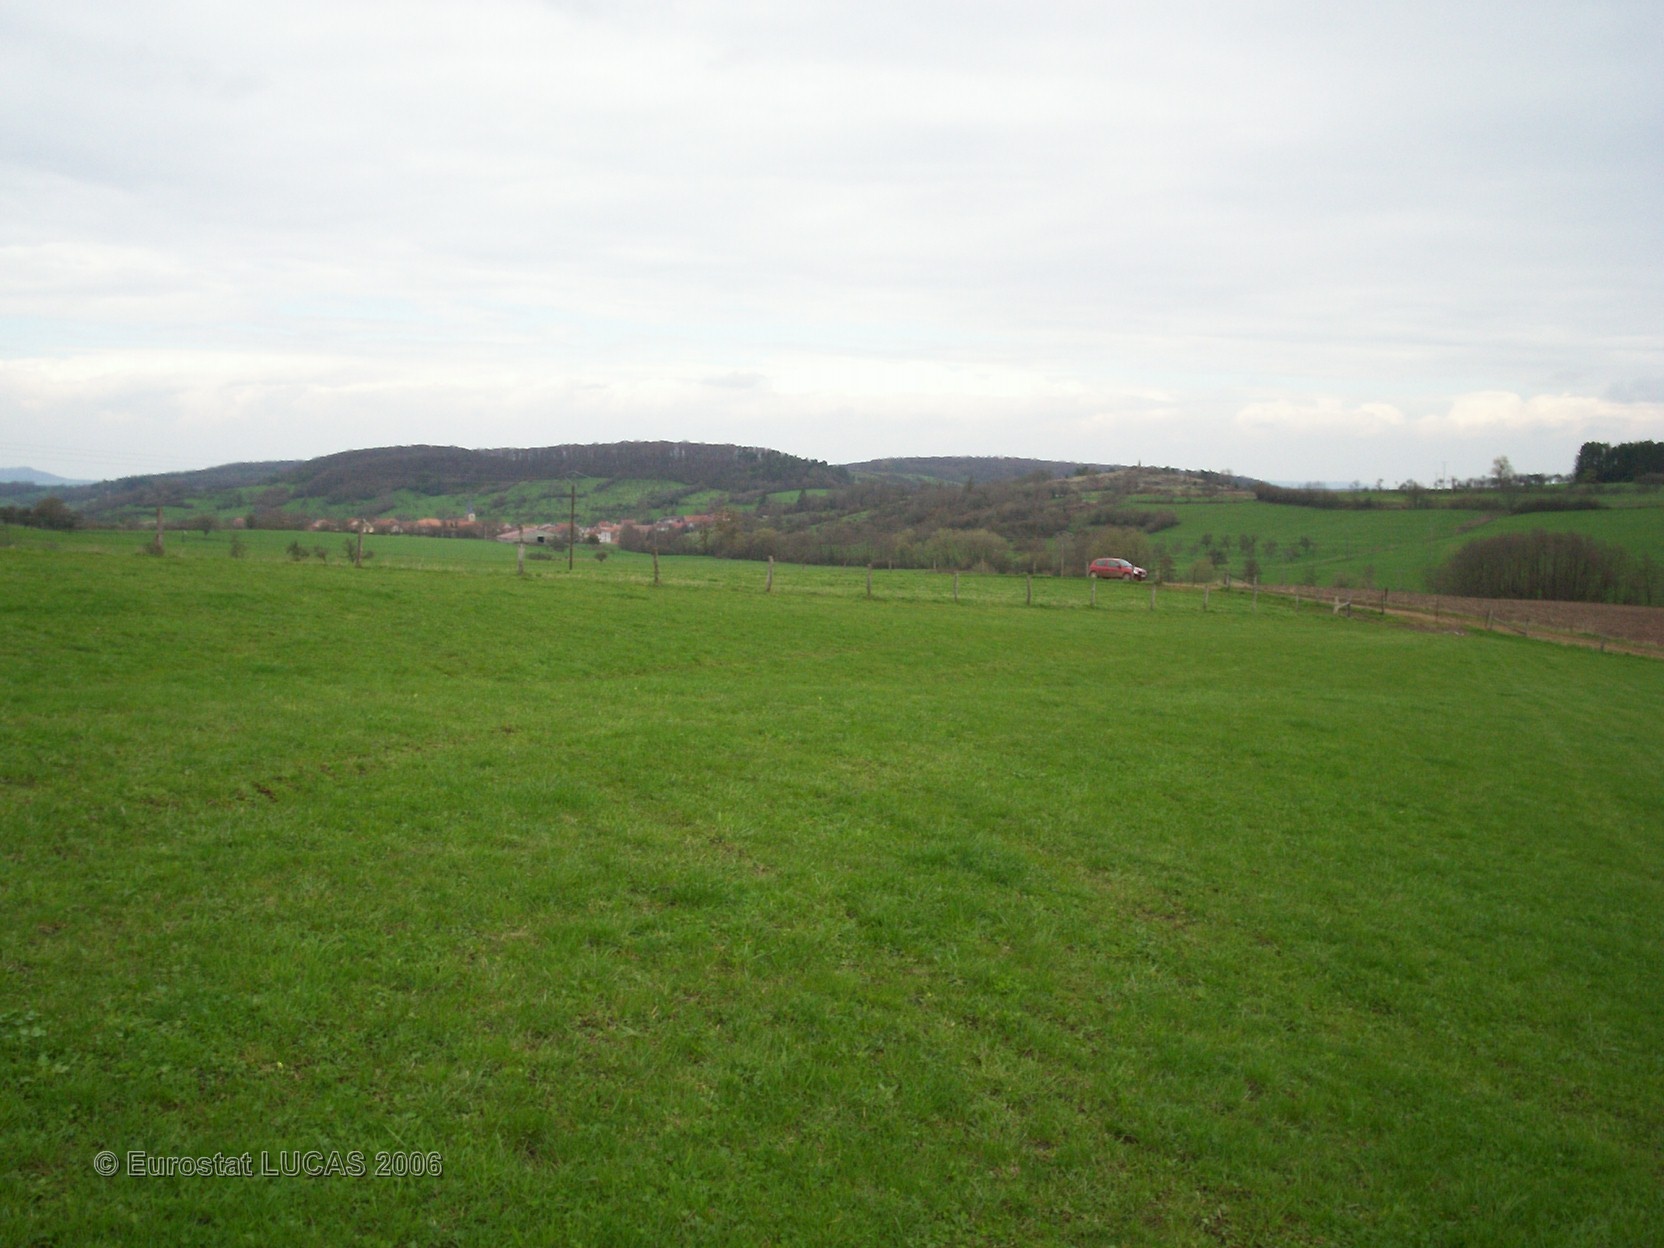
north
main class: Grassland
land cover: Grassland without tree/shrub cover
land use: Agriculture (excluding fallow land and kitchen gardens)
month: April
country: FR
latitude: 48.2411
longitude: 6.0011
